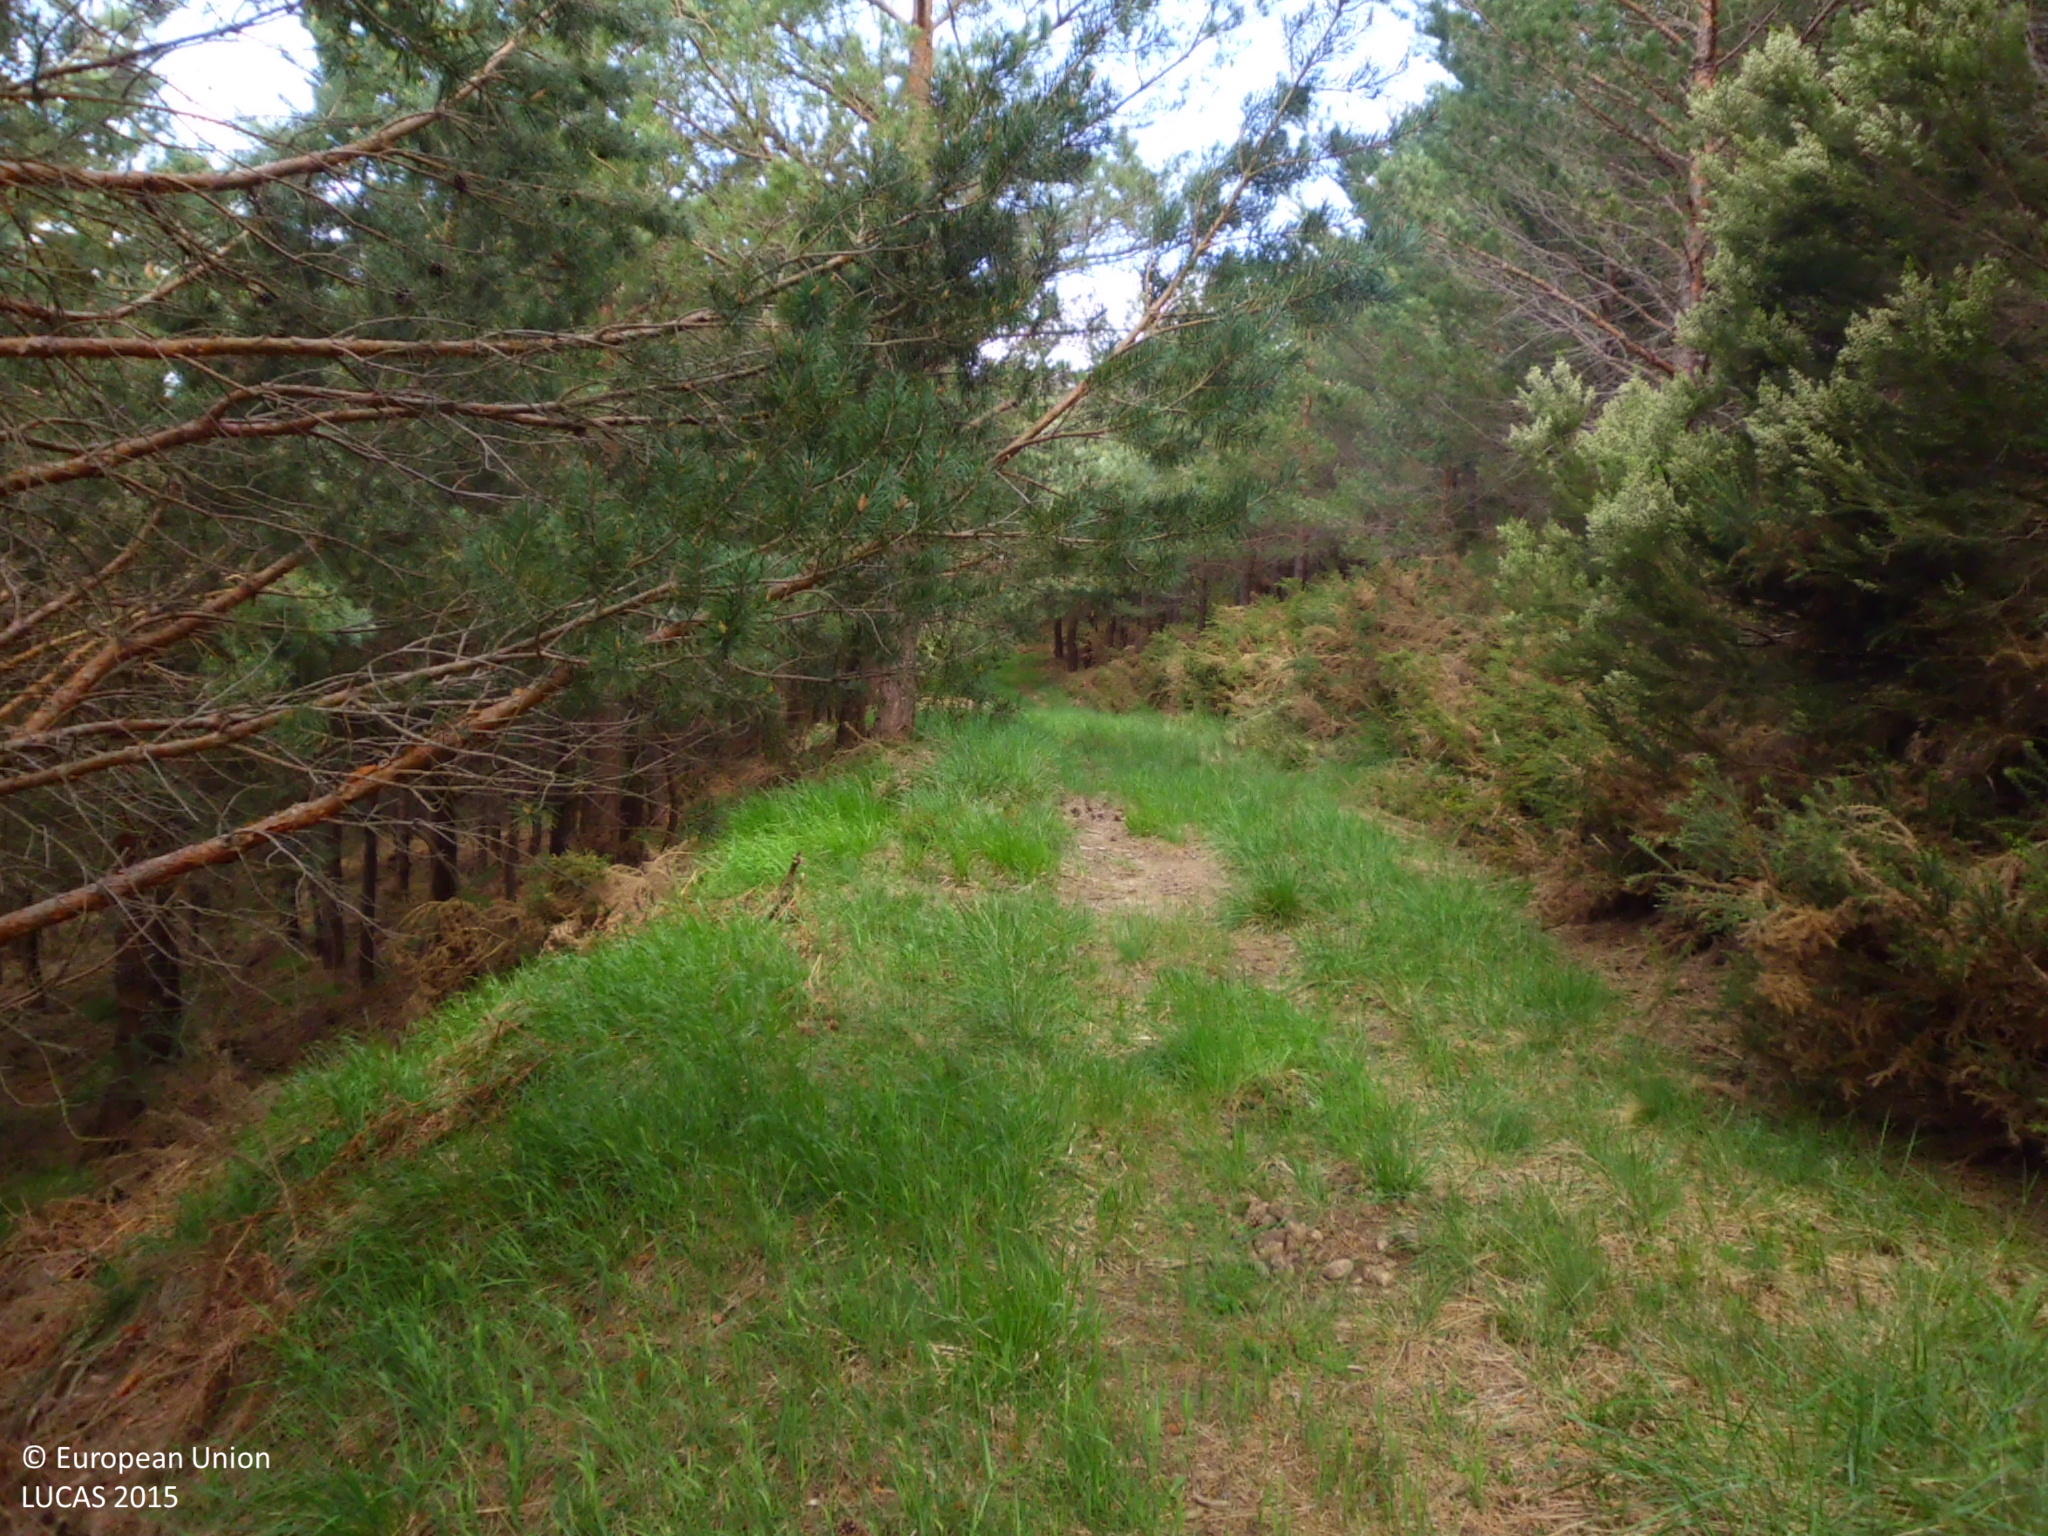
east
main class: Woodland
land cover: Pine dominated coniferous woodland
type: coniferous forest of the mediterranean region
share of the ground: > 75 %
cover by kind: coniferous forest trees 100 %
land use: Semi-natural and natural areas not in use
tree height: > 5 m
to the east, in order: Pine dominated coniferous woodland; Tracks; Pine dominated coniferous woodland; Tracks; Pine dominated coniferous woodland
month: May
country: ES
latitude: 42.8839
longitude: -3.8676
